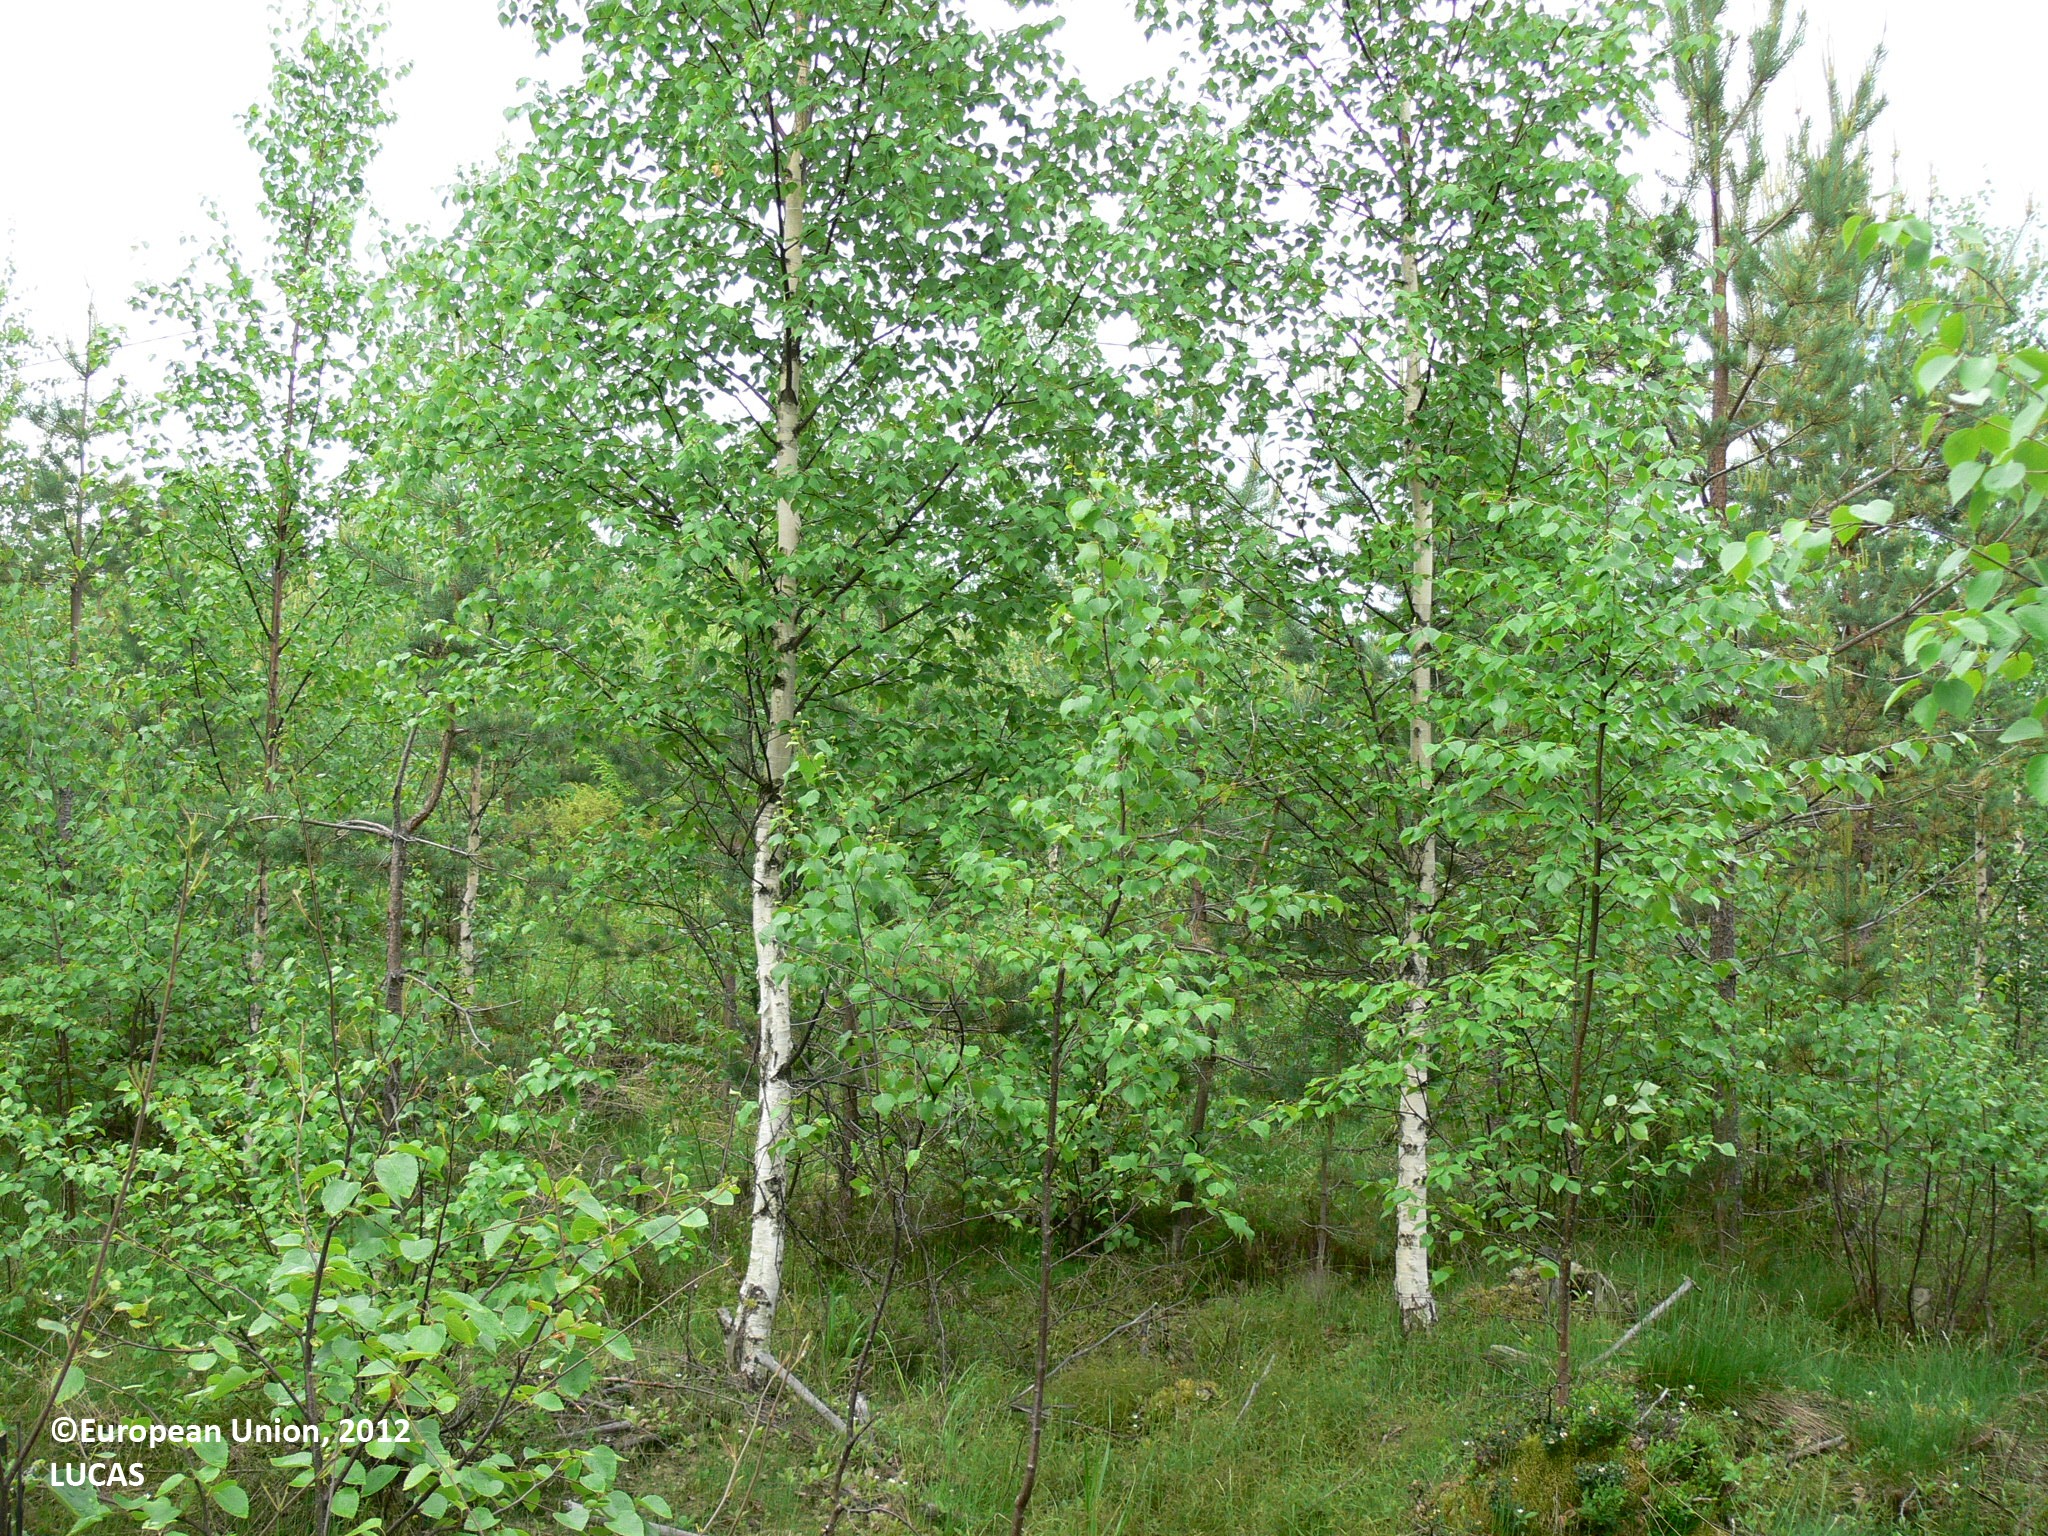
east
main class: Woodland
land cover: Other mixed woodland
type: boreal forest
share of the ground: > 75 %
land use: Forestry
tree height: < 5 m
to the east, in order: Other mixed woodland; Shruby margins; Electric lines; Shruby margins; Pine dominated mixed woodland; Pine dominated coniferous woodland; Other coniferous woodland; Other mixed woodland; Ditches and canals; Other mixed woodland; Ditches and canals; Other mixed woodland; Pine dominated mixed woodland
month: June
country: FI
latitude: 62.9562
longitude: 29.8236
